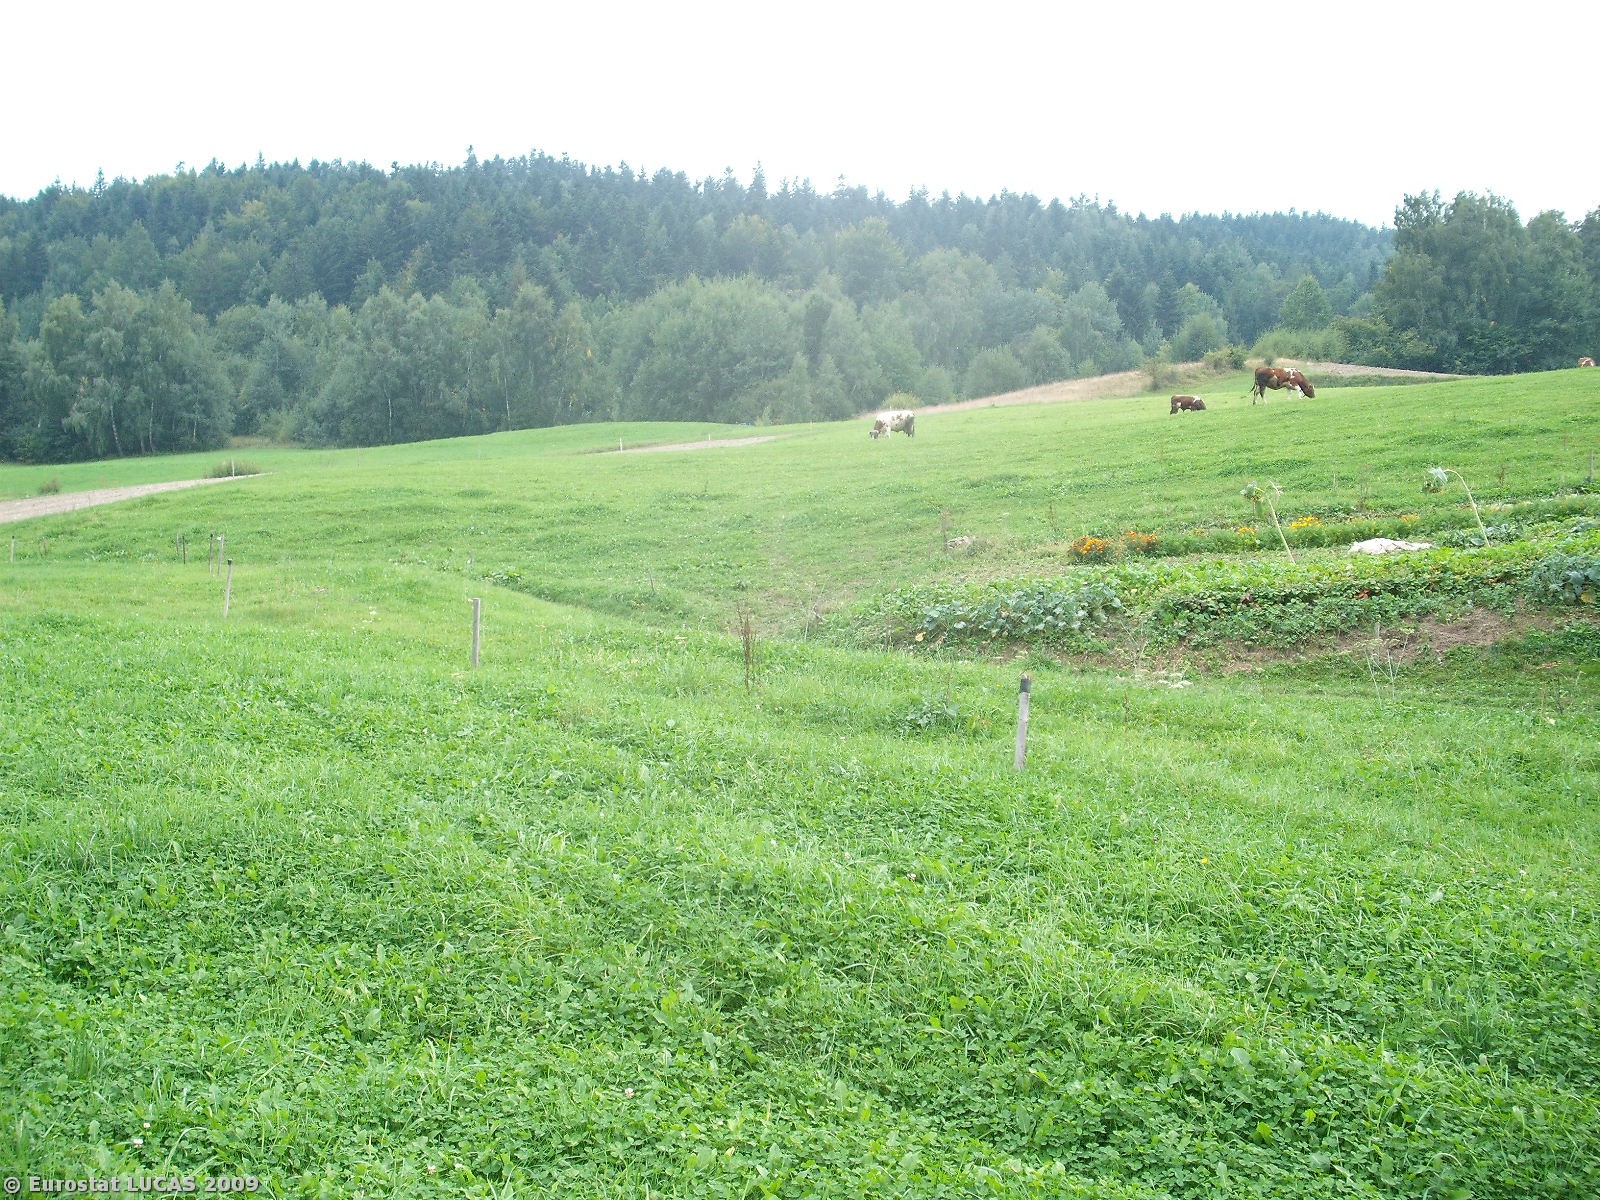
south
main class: Cropland
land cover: Clovers
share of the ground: > 75 %
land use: Agriculture (excluding fallow land and kitchen gardens)
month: September
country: PL
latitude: 49.6671
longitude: 20.4419
